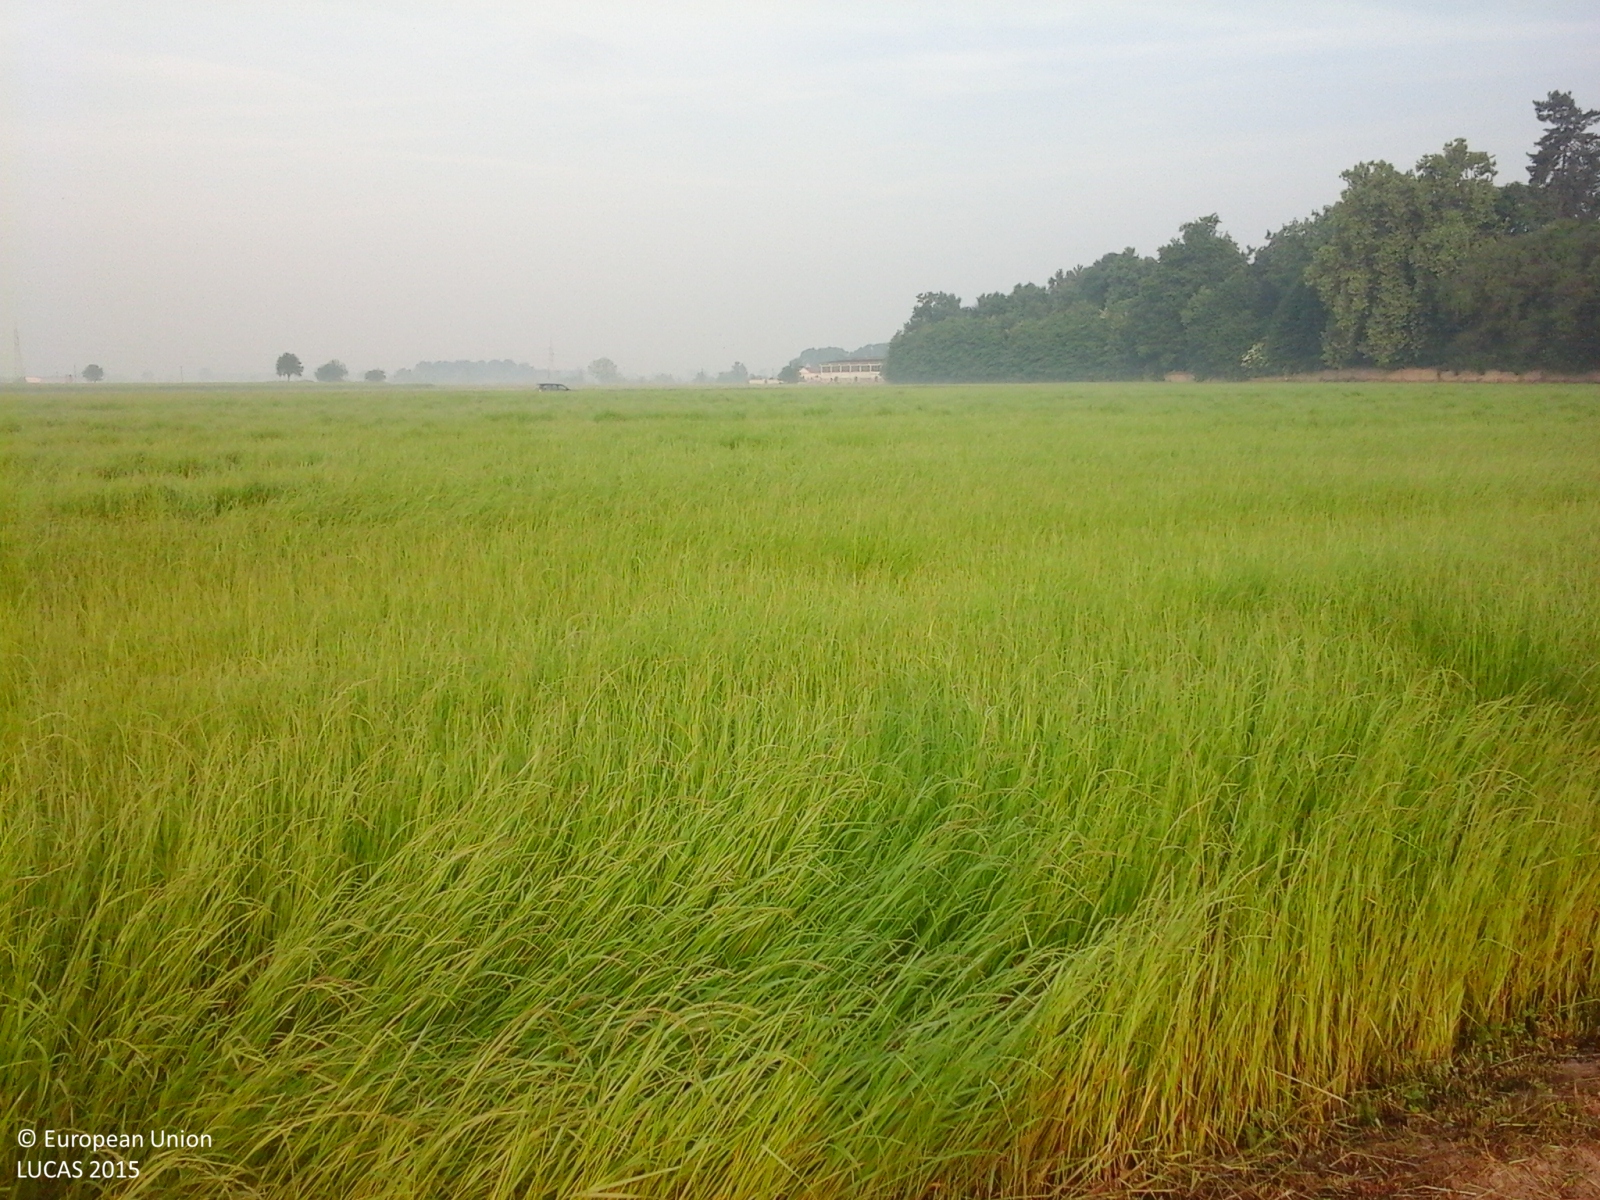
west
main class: Cropland
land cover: Temporary grasslands
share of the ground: > 75 %
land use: Agriculture (excluding fallow land and kitchen gardens)
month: May
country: IT
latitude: 44.9031
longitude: 7.7372
